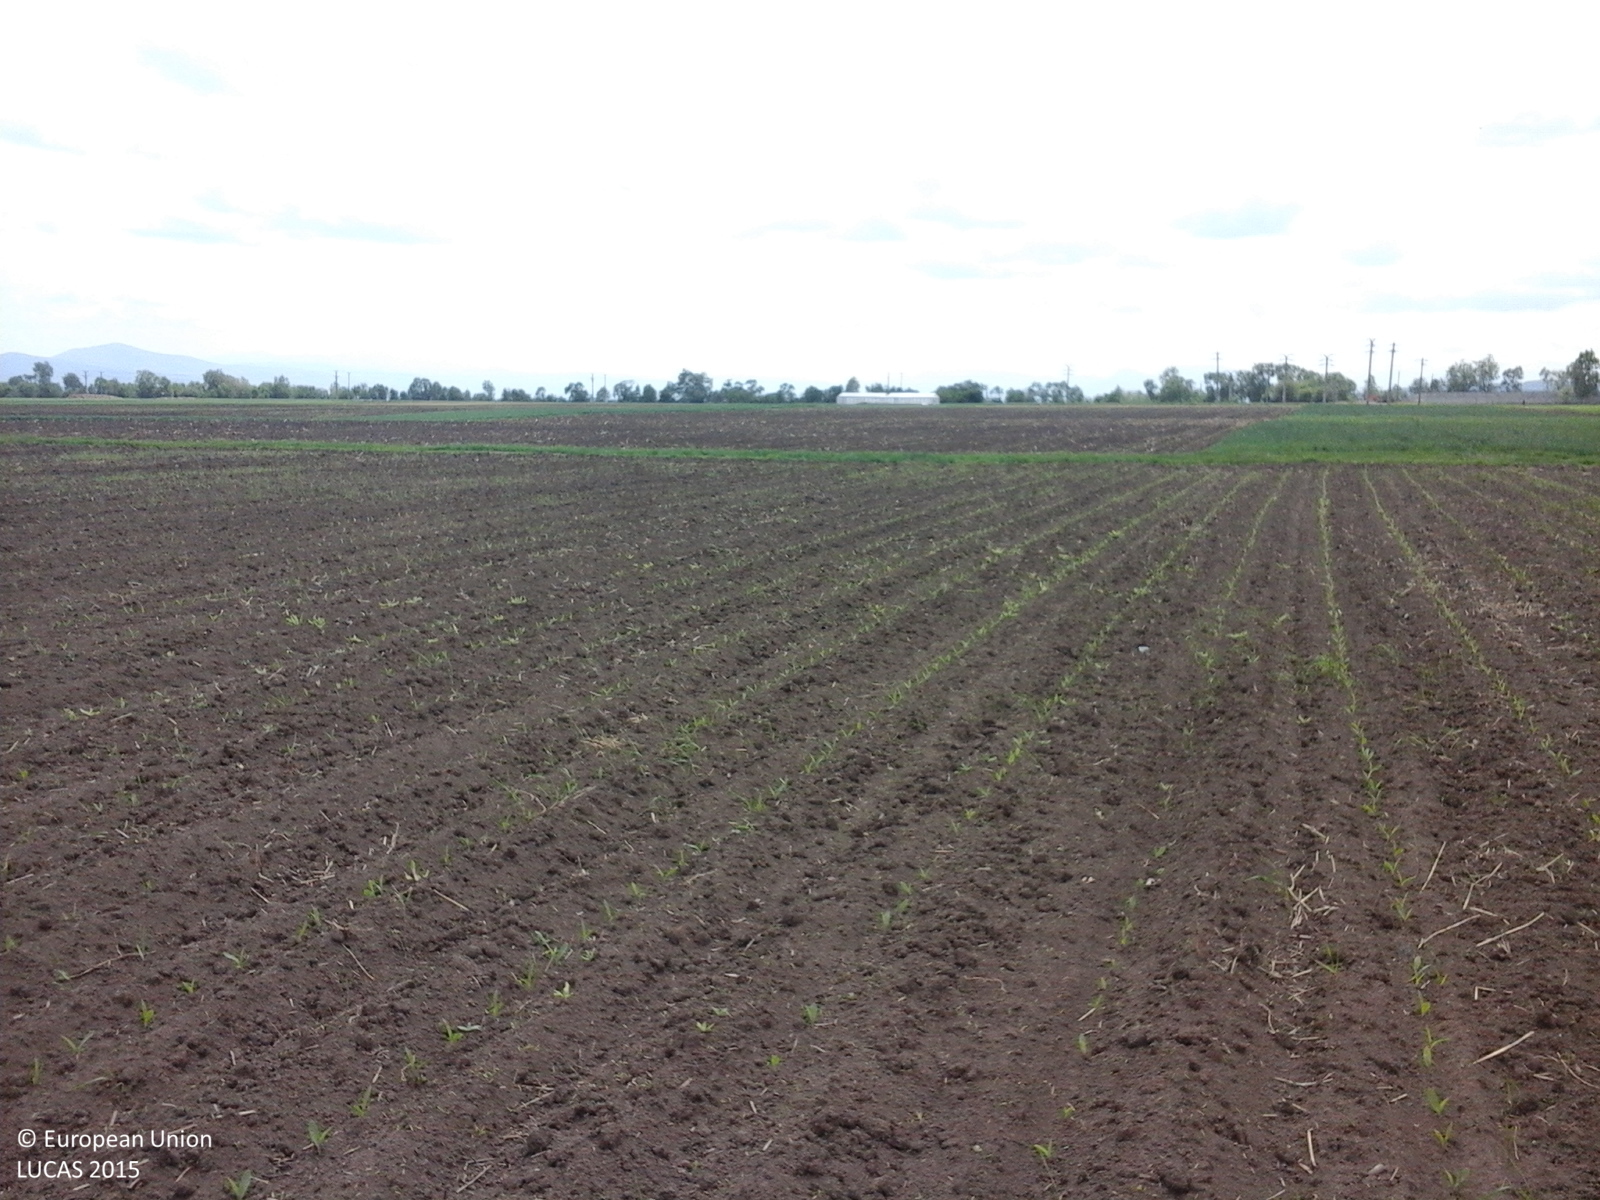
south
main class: Cropland
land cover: Maize
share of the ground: < 10 %
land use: Agriculture (excluding fallow land and kitchen gardens)
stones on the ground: < 10 %
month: May
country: RO
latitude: 45.9190
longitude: 25.8031
